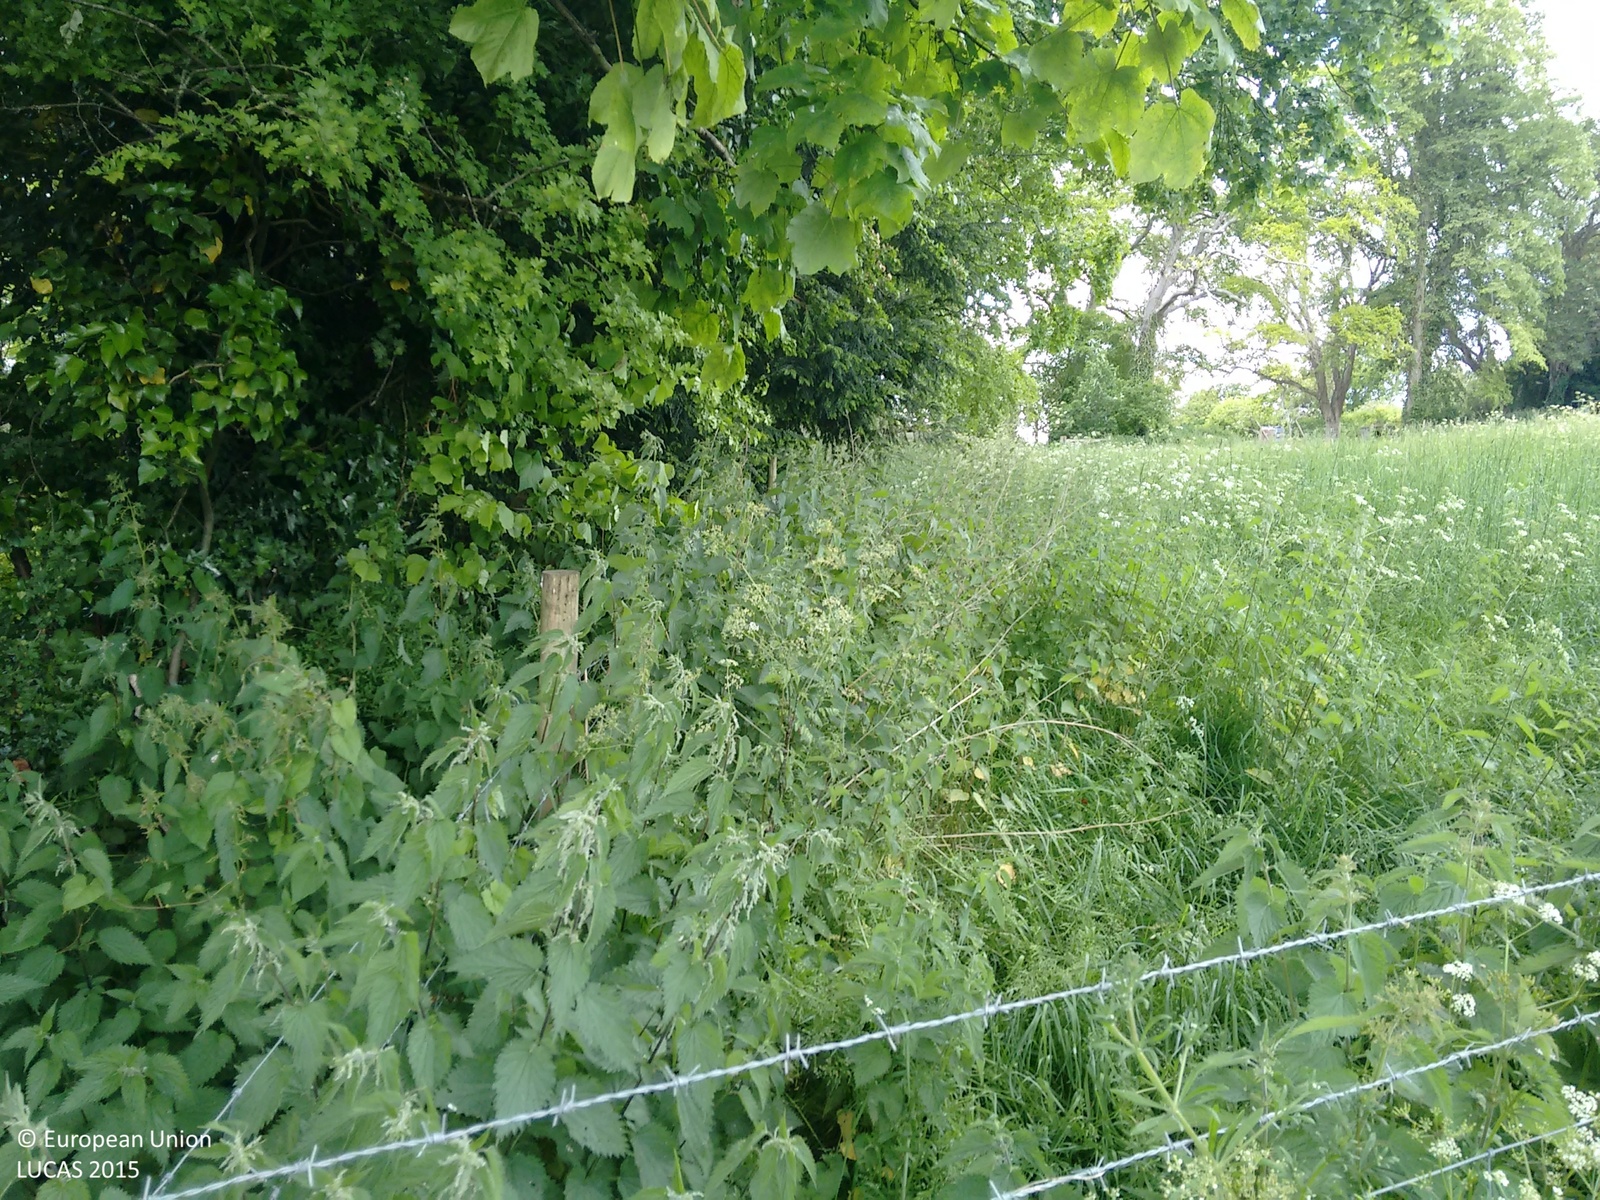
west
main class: Woodland
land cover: Broadleaved woodland
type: mesophytic deciduous forest
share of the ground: > 75 %
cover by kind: broadleaved forest trees 100 %
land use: Residential
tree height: > 5 m
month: June
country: GB
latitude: 51.0834
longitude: -1.9200
